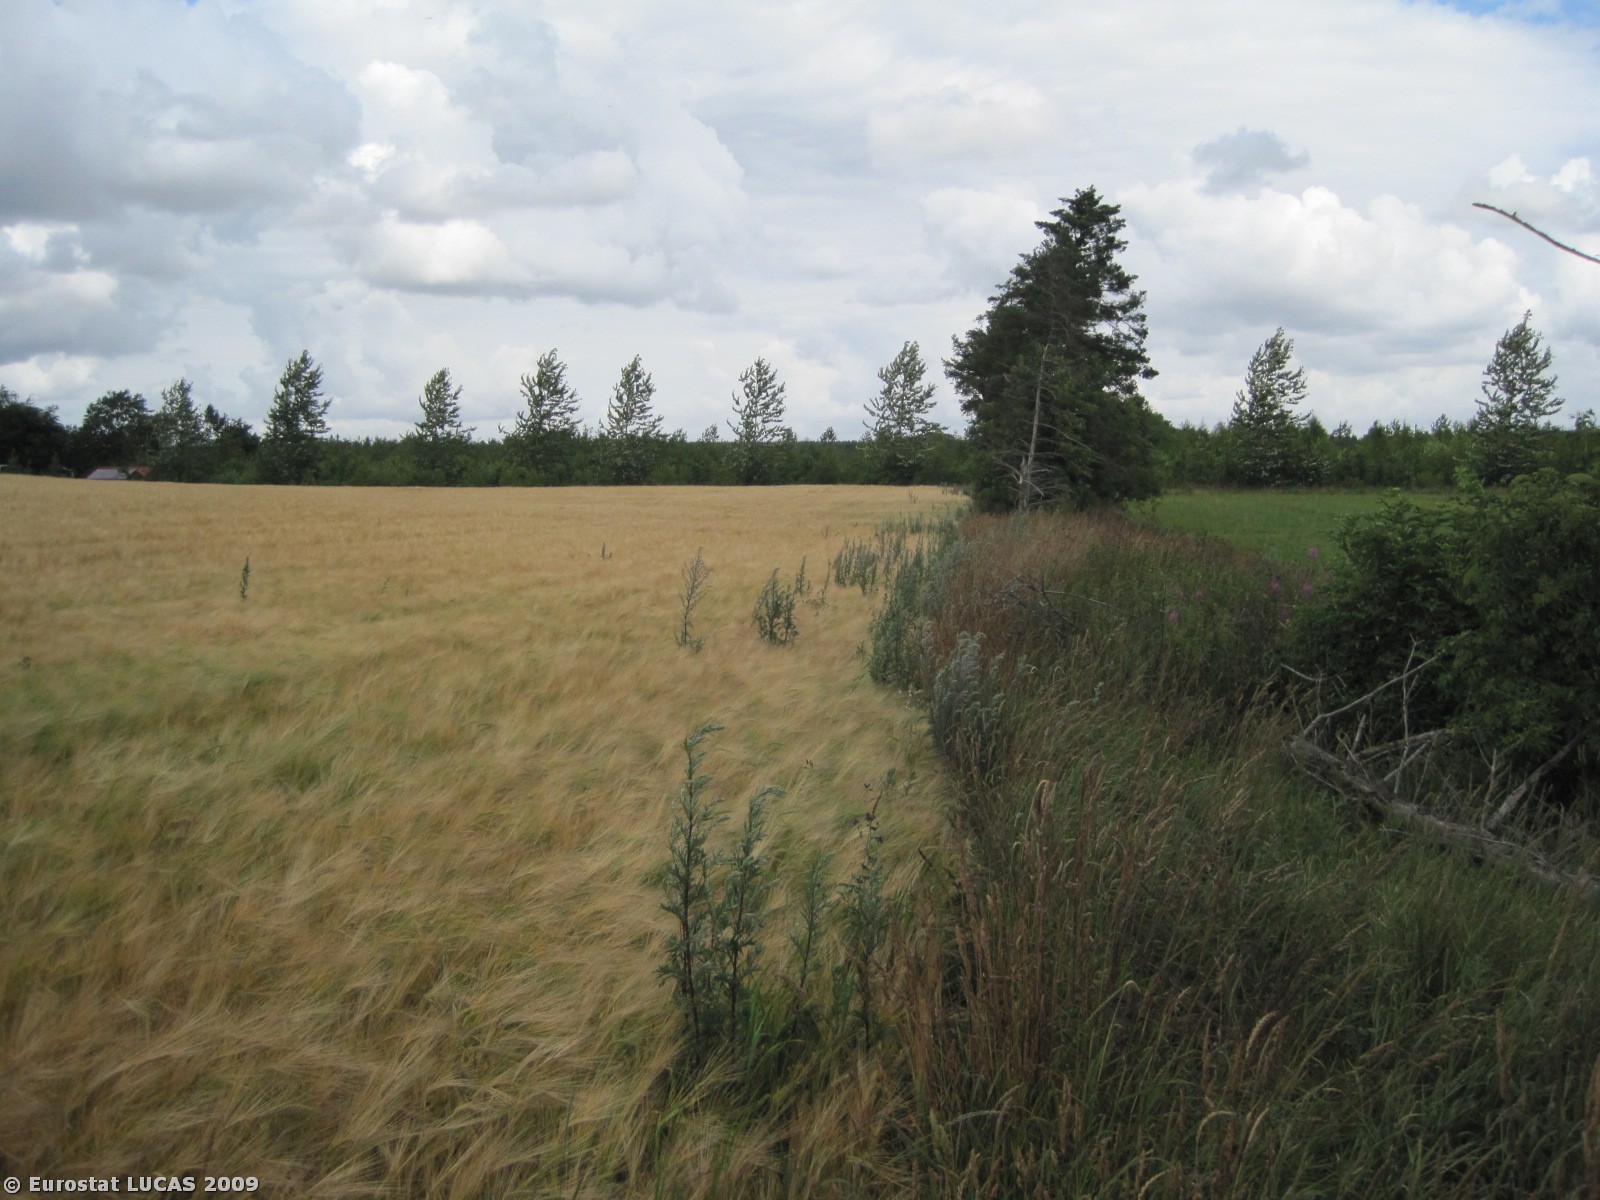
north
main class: Cropland
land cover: Barley
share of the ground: > 75 %
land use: Agriculture (excluding fallow land and kitchen gardens)
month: July
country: DK
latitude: 56.3804
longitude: 8.8516
